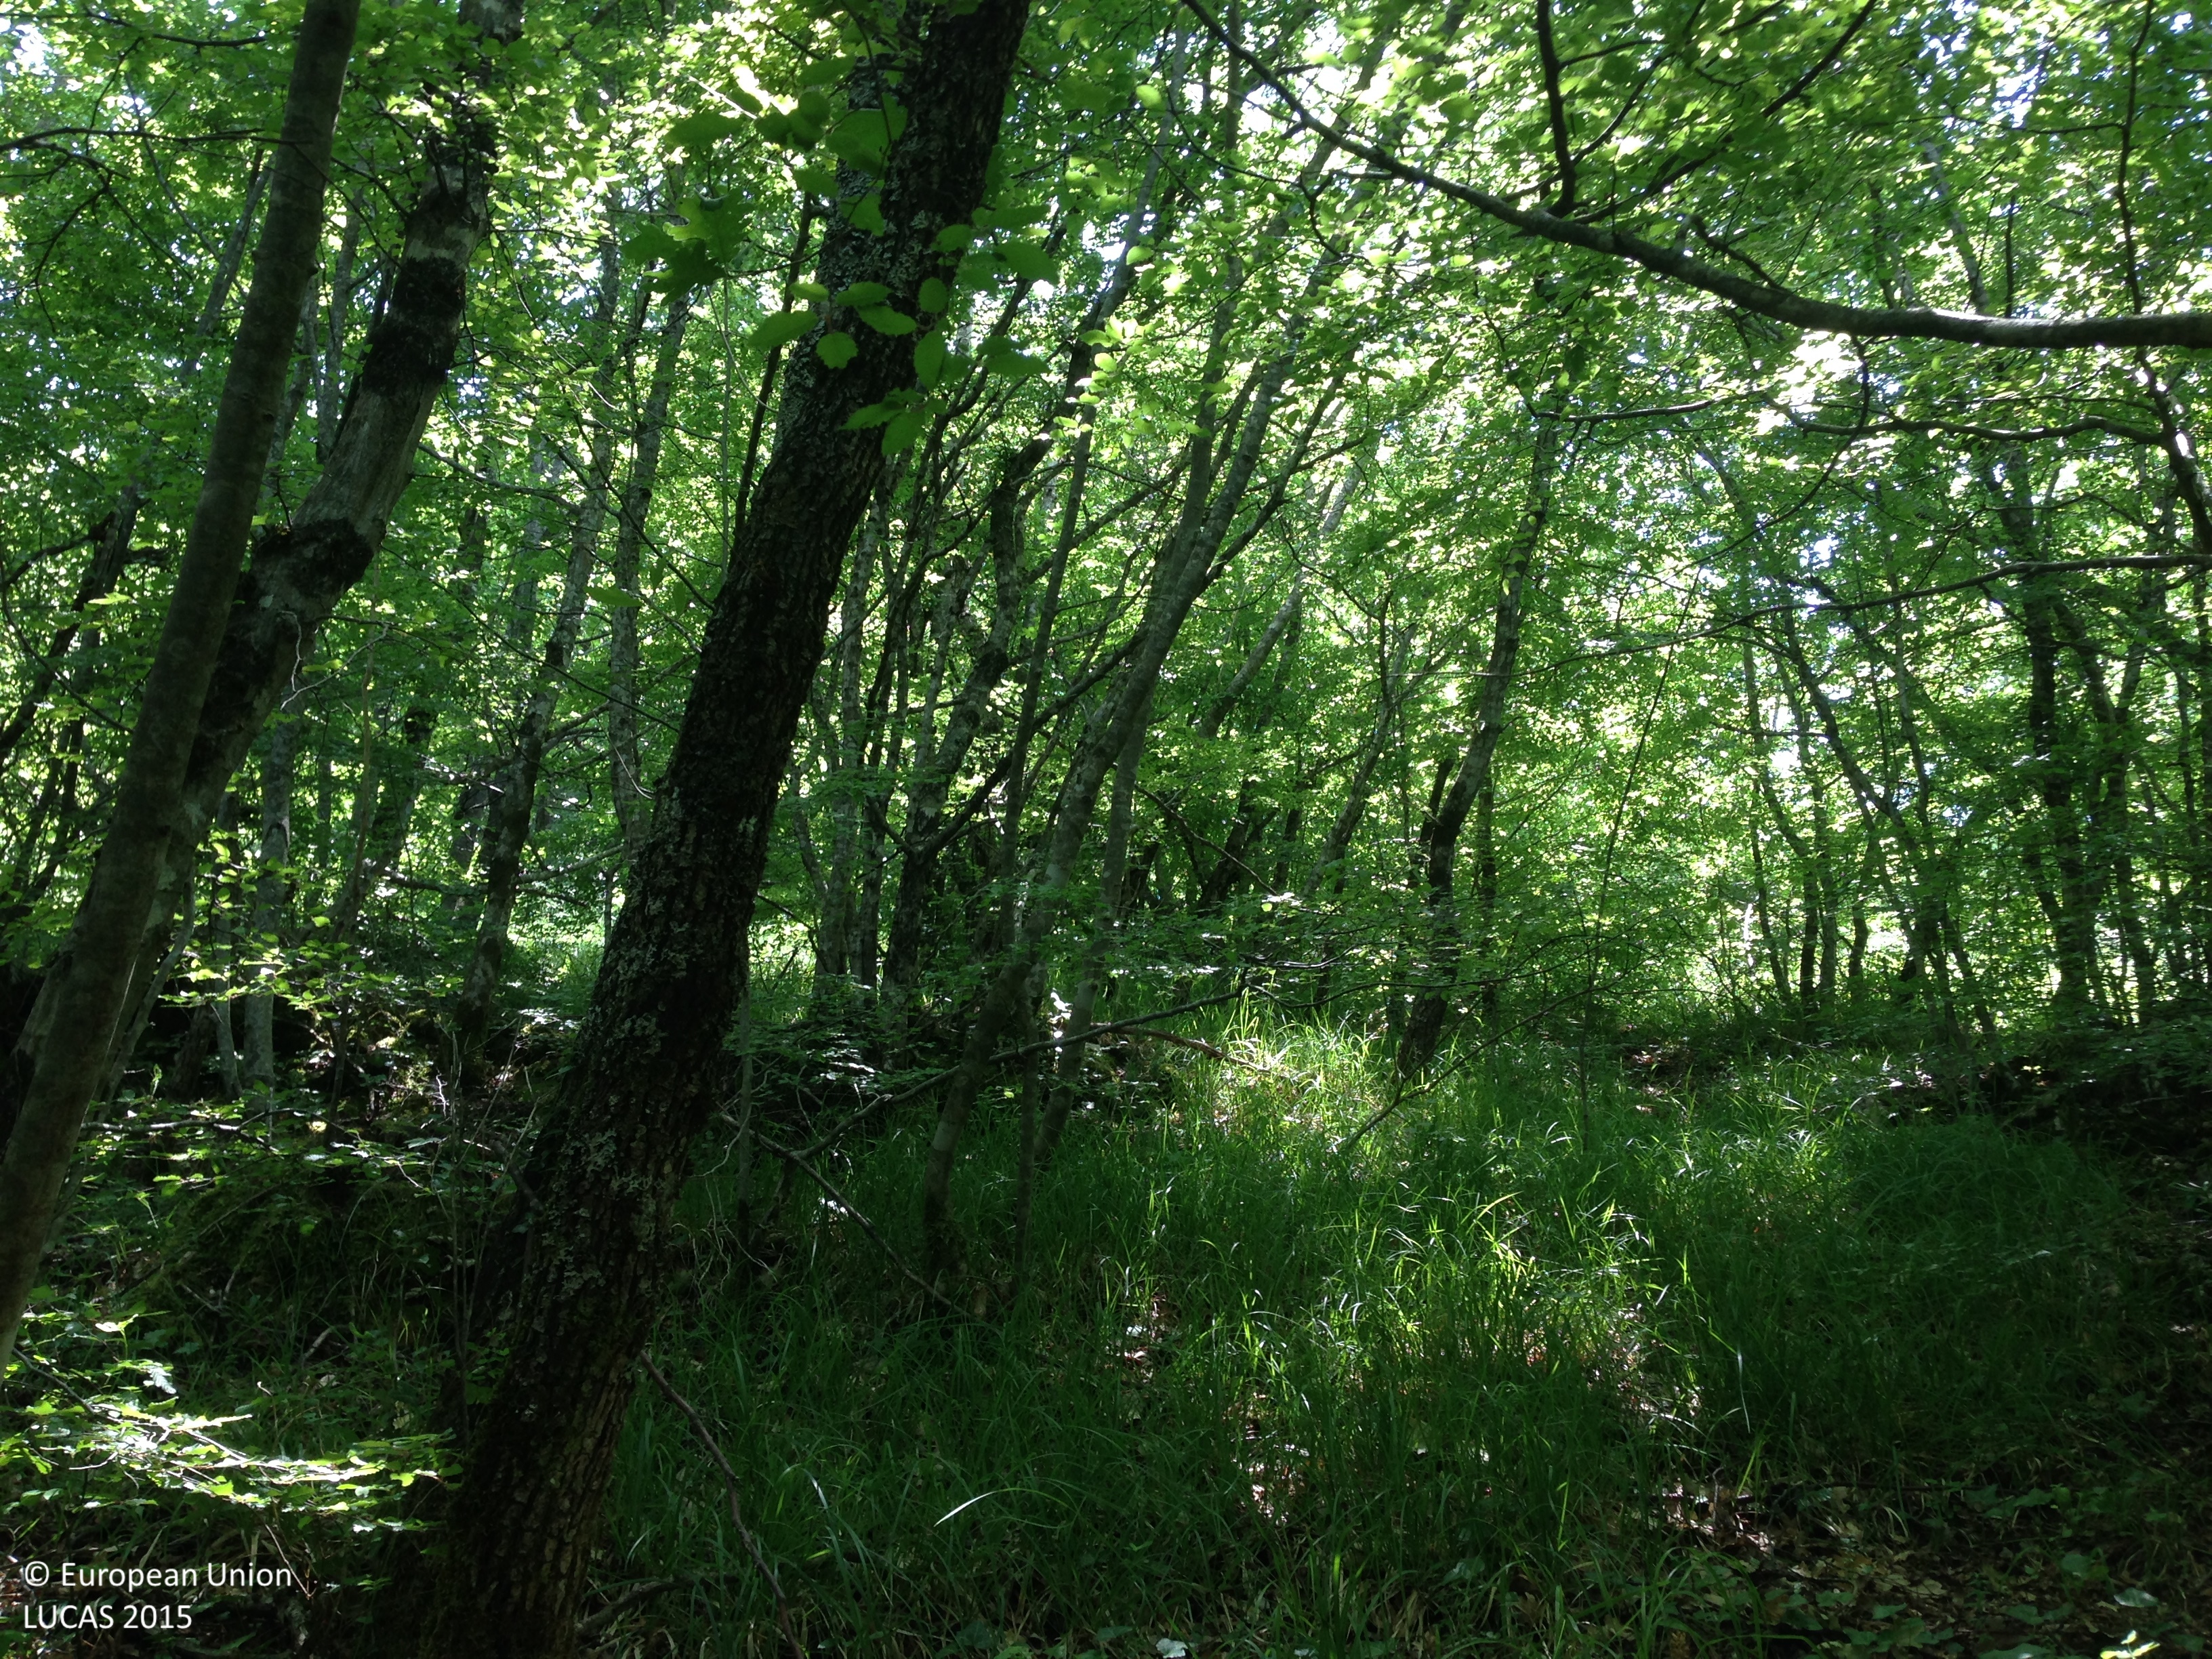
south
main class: Woodland
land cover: Broadleaved woodland
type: thermophilous deciduous forest
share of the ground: > 75 %
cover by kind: broadleaved forest trees 75 %, shrubs 10 %, herbaceous plants 5 %, consolidated bare surface 5 %, unconsolidated bare surface 5 %
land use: Semi-natural and natural areas not in use
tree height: > 5 m
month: June
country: HR
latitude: 43.7331
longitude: 16.4601
